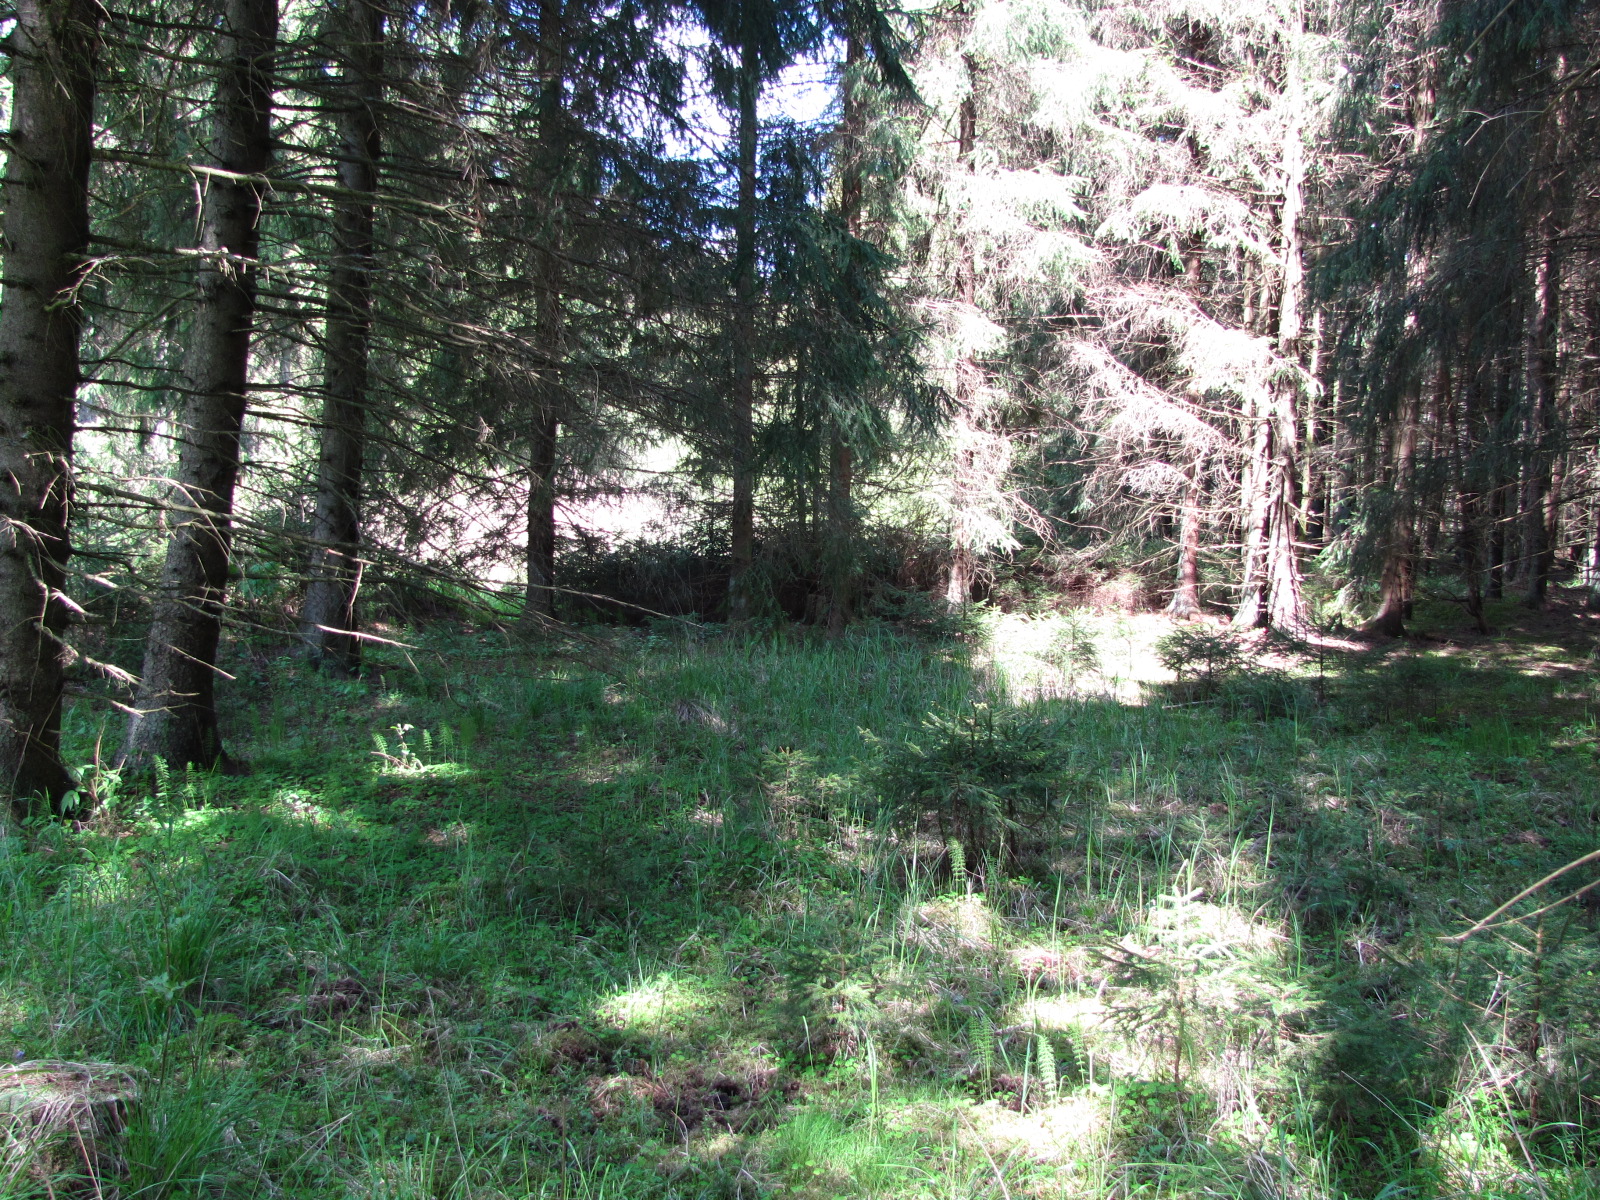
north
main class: Woodland
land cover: Other coniferous woodland
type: hemiboreal forest and nemoral coniferous forest and mixed broadleaved-coniferous forest
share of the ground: > 75 %
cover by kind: coniferous forest trees 100 %
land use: Forestry
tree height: > 5 m
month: May
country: LV
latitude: 56.7842
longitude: 24.5153
